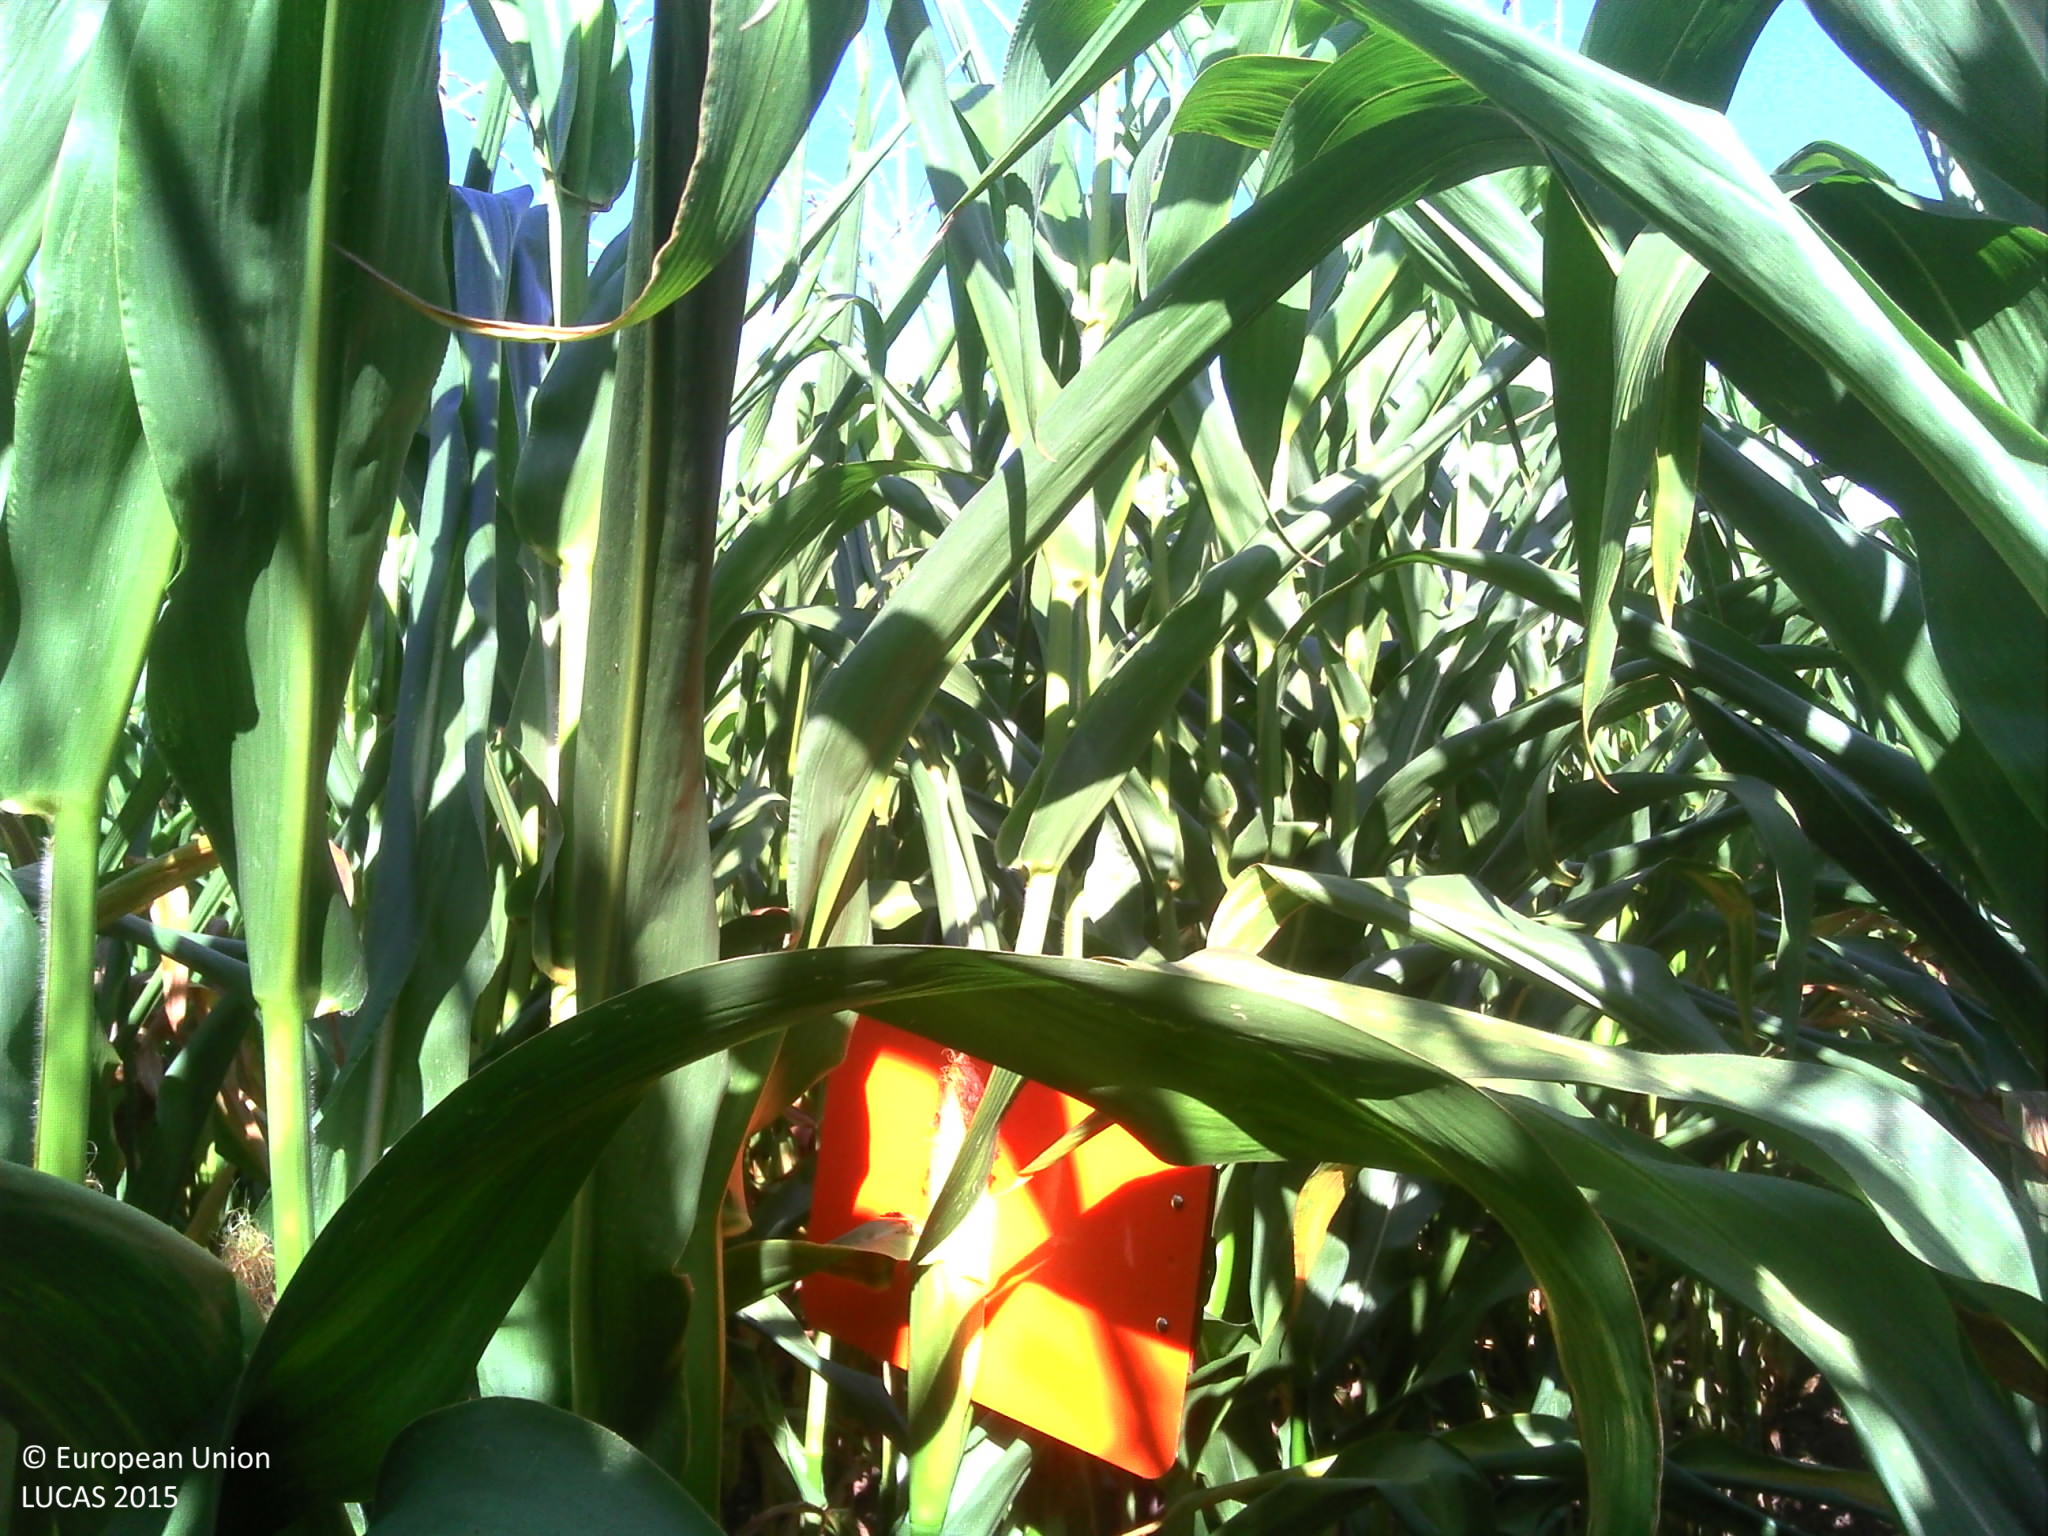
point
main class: Cropland
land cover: Maize
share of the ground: > 75 %
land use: Agriculture (excluding fallow land and kitchen gardens)
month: August
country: FR
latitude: 46.7438
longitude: -1.3591
